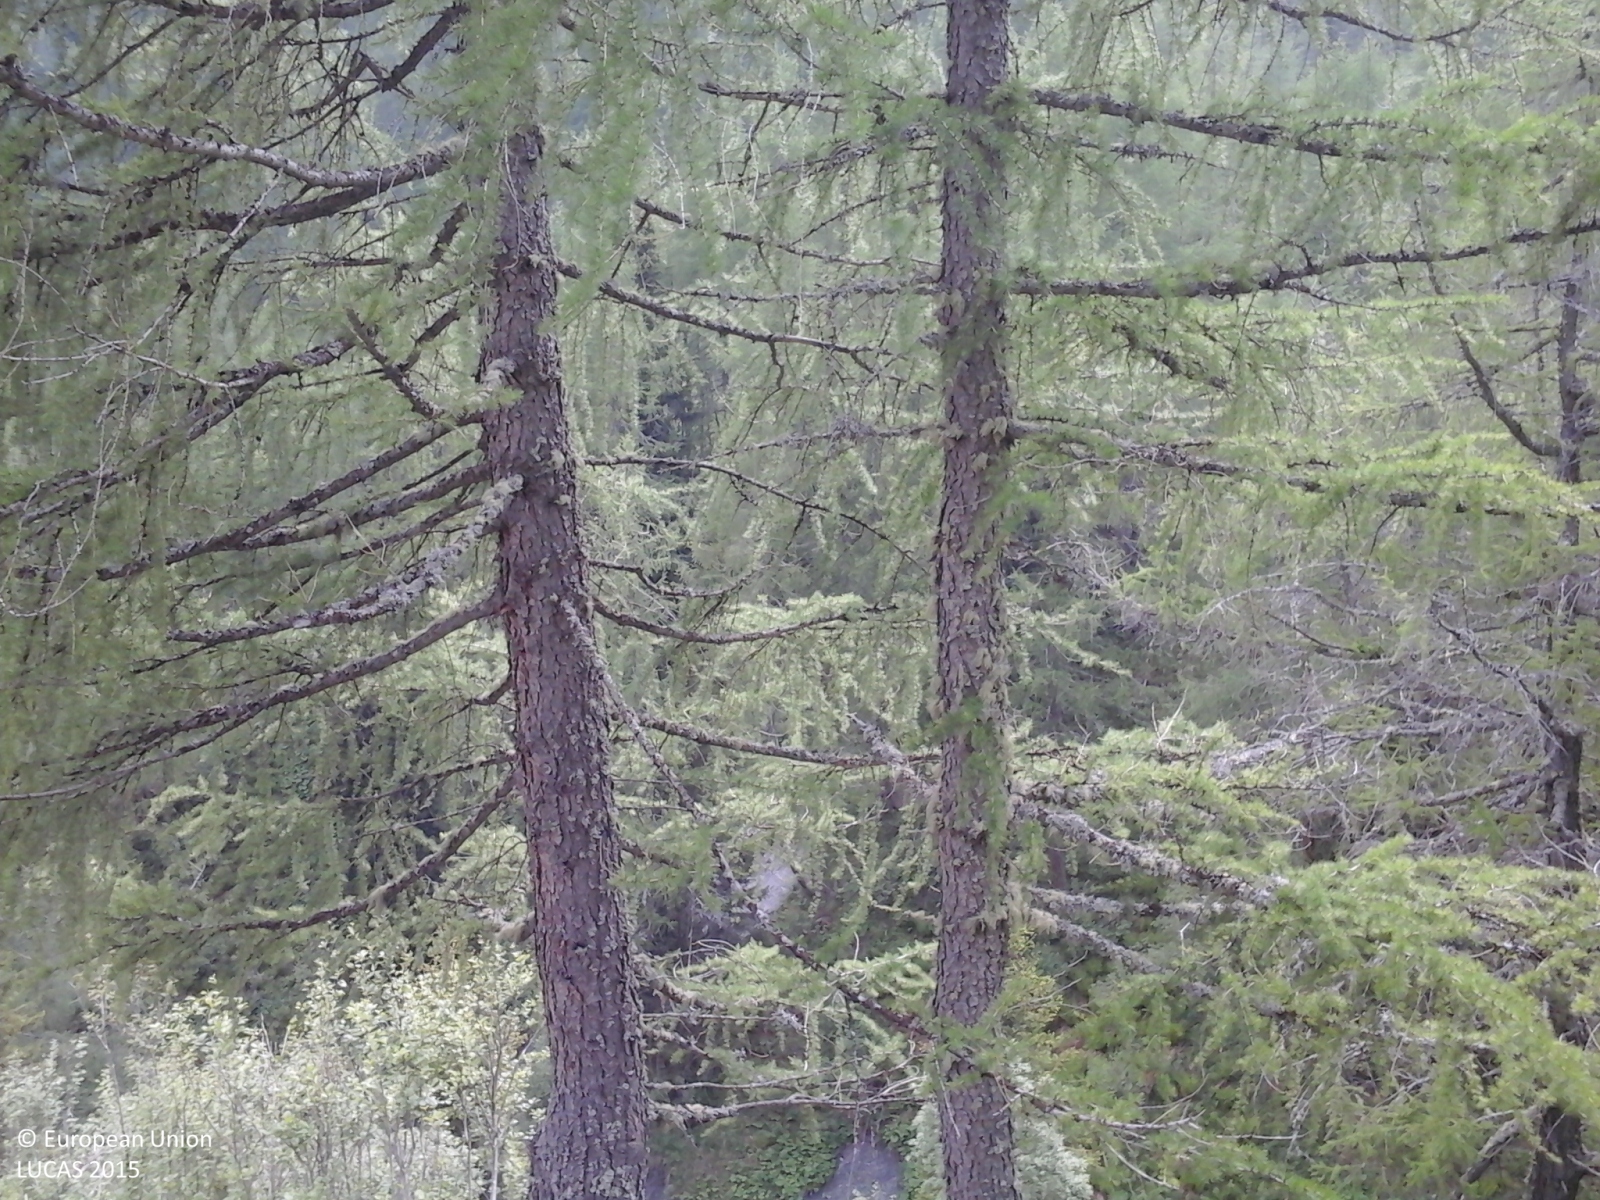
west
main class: Woodland
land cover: Spruce dominated coniferous woodland
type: alpine coniferous forest
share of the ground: > 75 %
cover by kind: herbaceous plants 80 %, coniferous forest trees 15 %, shrubs 5 %
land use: Semi-natural and natural areas not in use
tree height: > 5 m
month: June
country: IT
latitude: 46.6645
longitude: 12.4938
